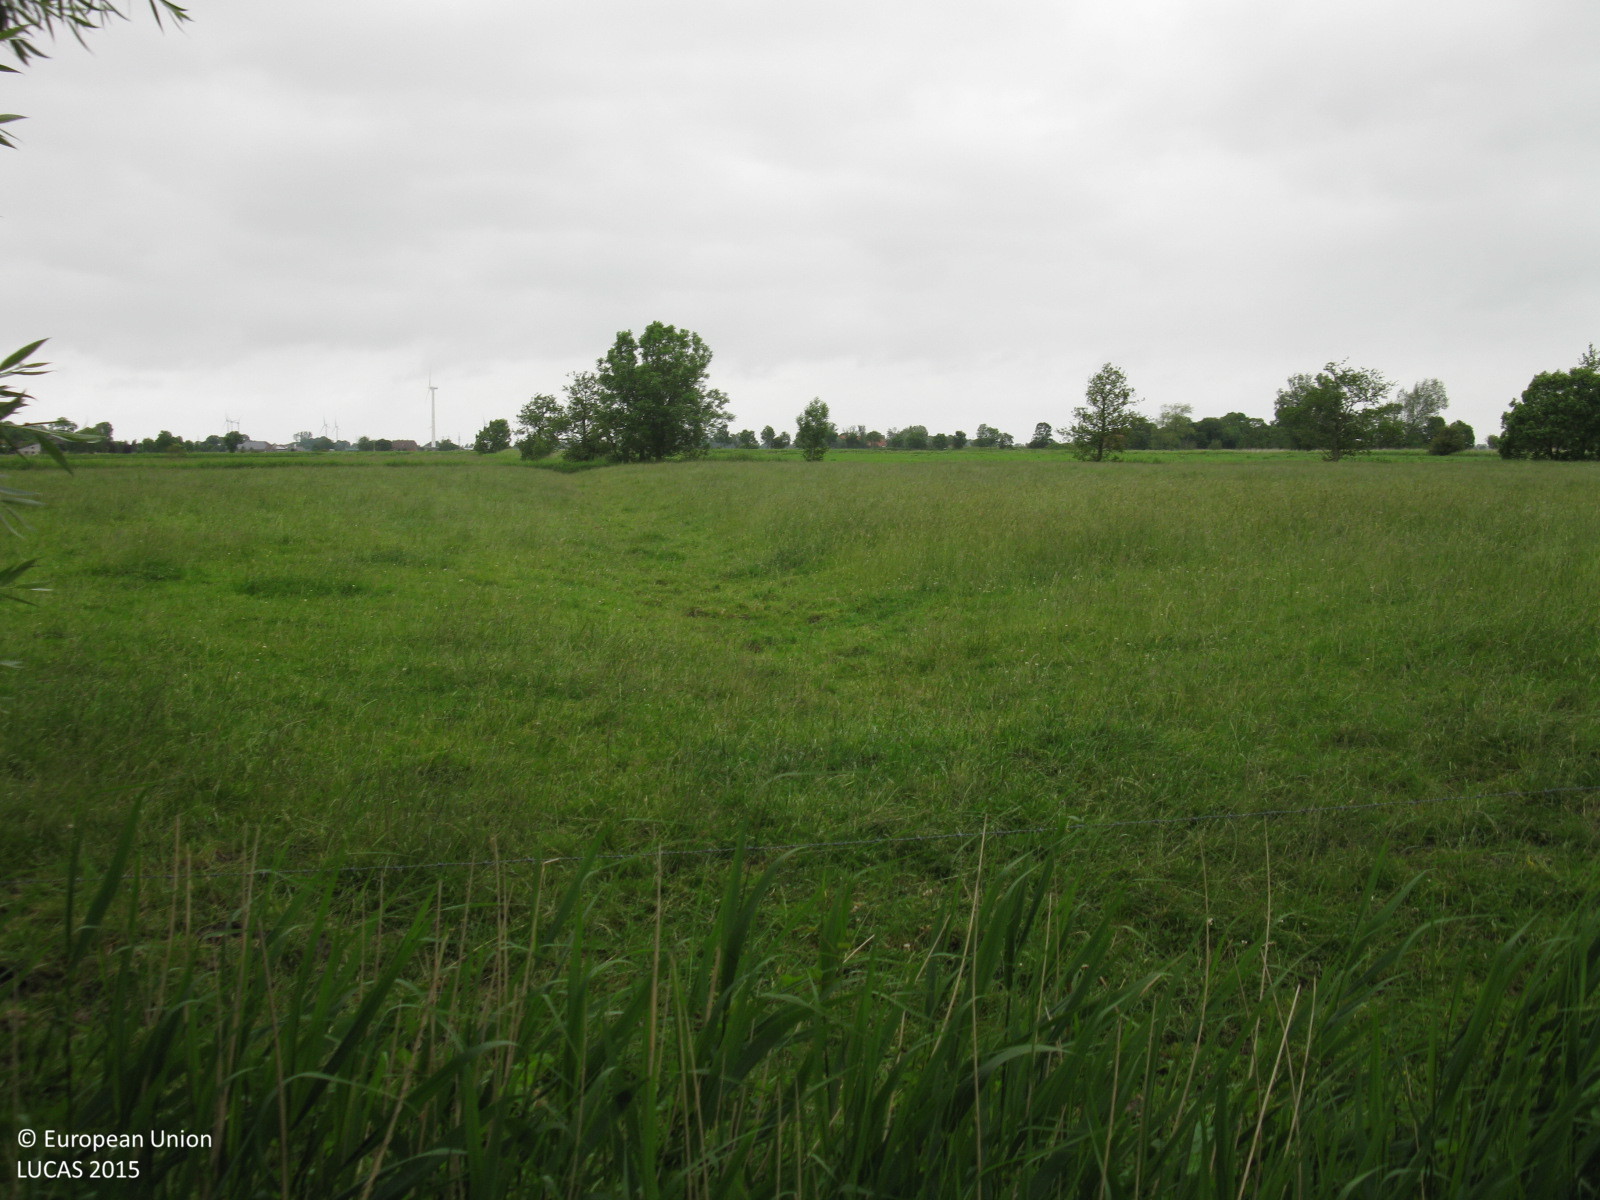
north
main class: Grassland
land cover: Grassland without tree/shrub cover
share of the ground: > 75 %
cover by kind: herbaceous plants 100 %
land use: Agriculture (excluding fallow land and kitchen gardens)
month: June
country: DE
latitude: 53.6359
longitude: 7.9288
